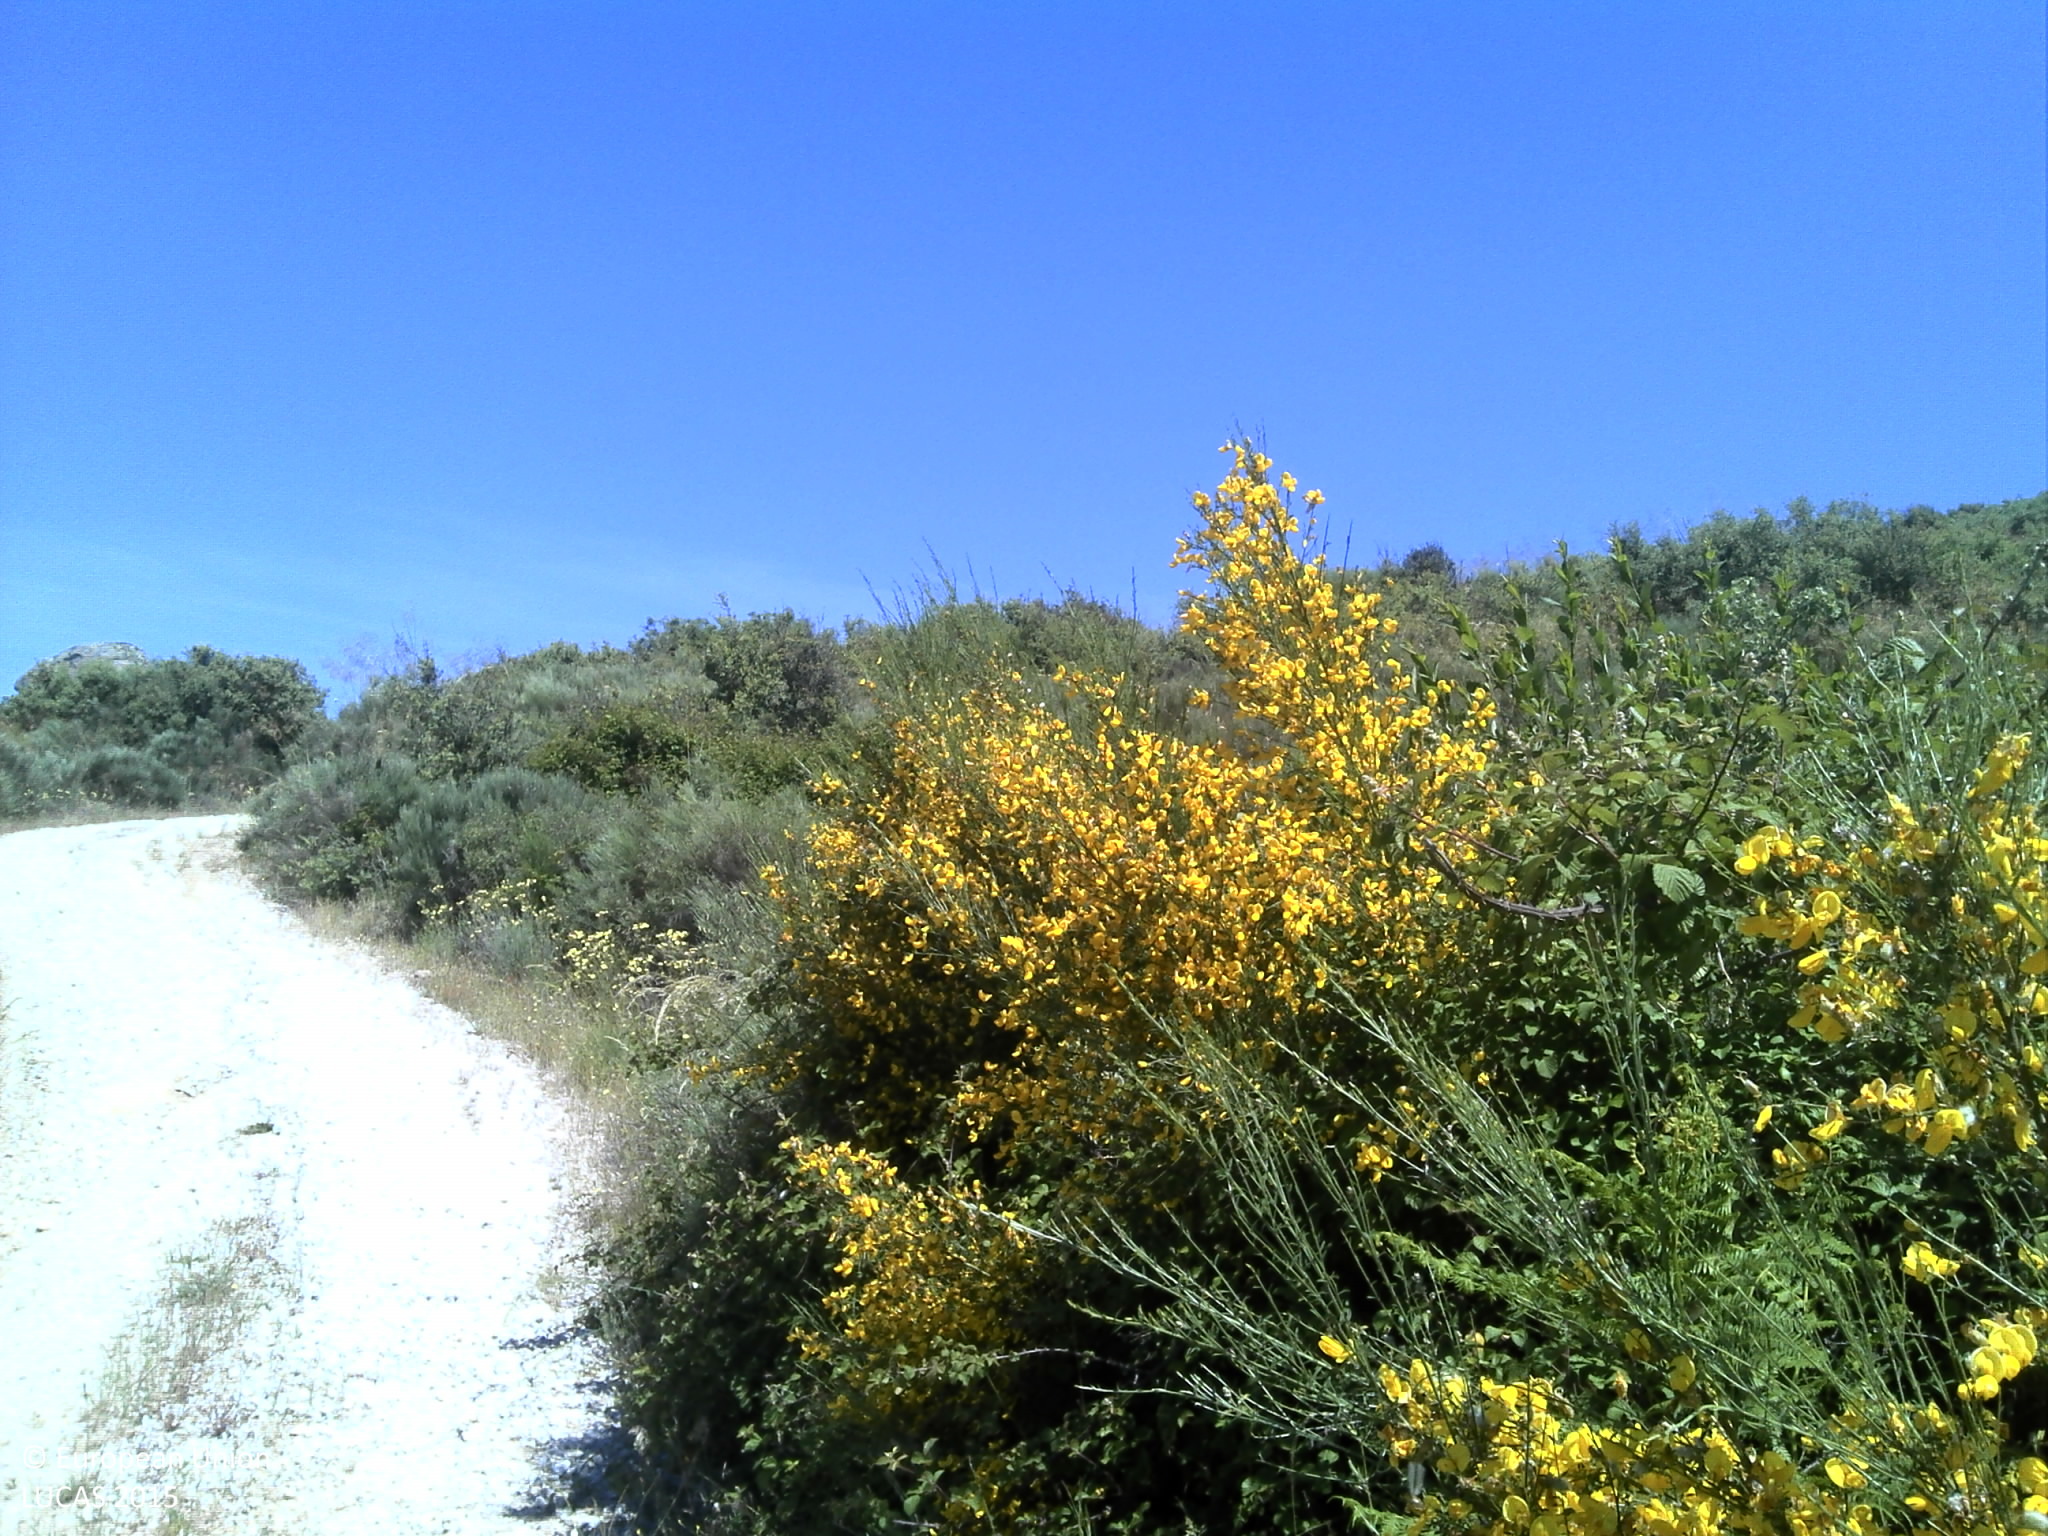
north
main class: Shrubland
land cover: Shrubland with sparse tree cover
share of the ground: > 75 %
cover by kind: shrubs 80 %, herbaceous plants 10 %, broadleaved forest trees 5 %
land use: Semi-natural and natural areas not in use
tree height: < 5 m
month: May
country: PT
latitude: 40.6244
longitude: -7.2603
